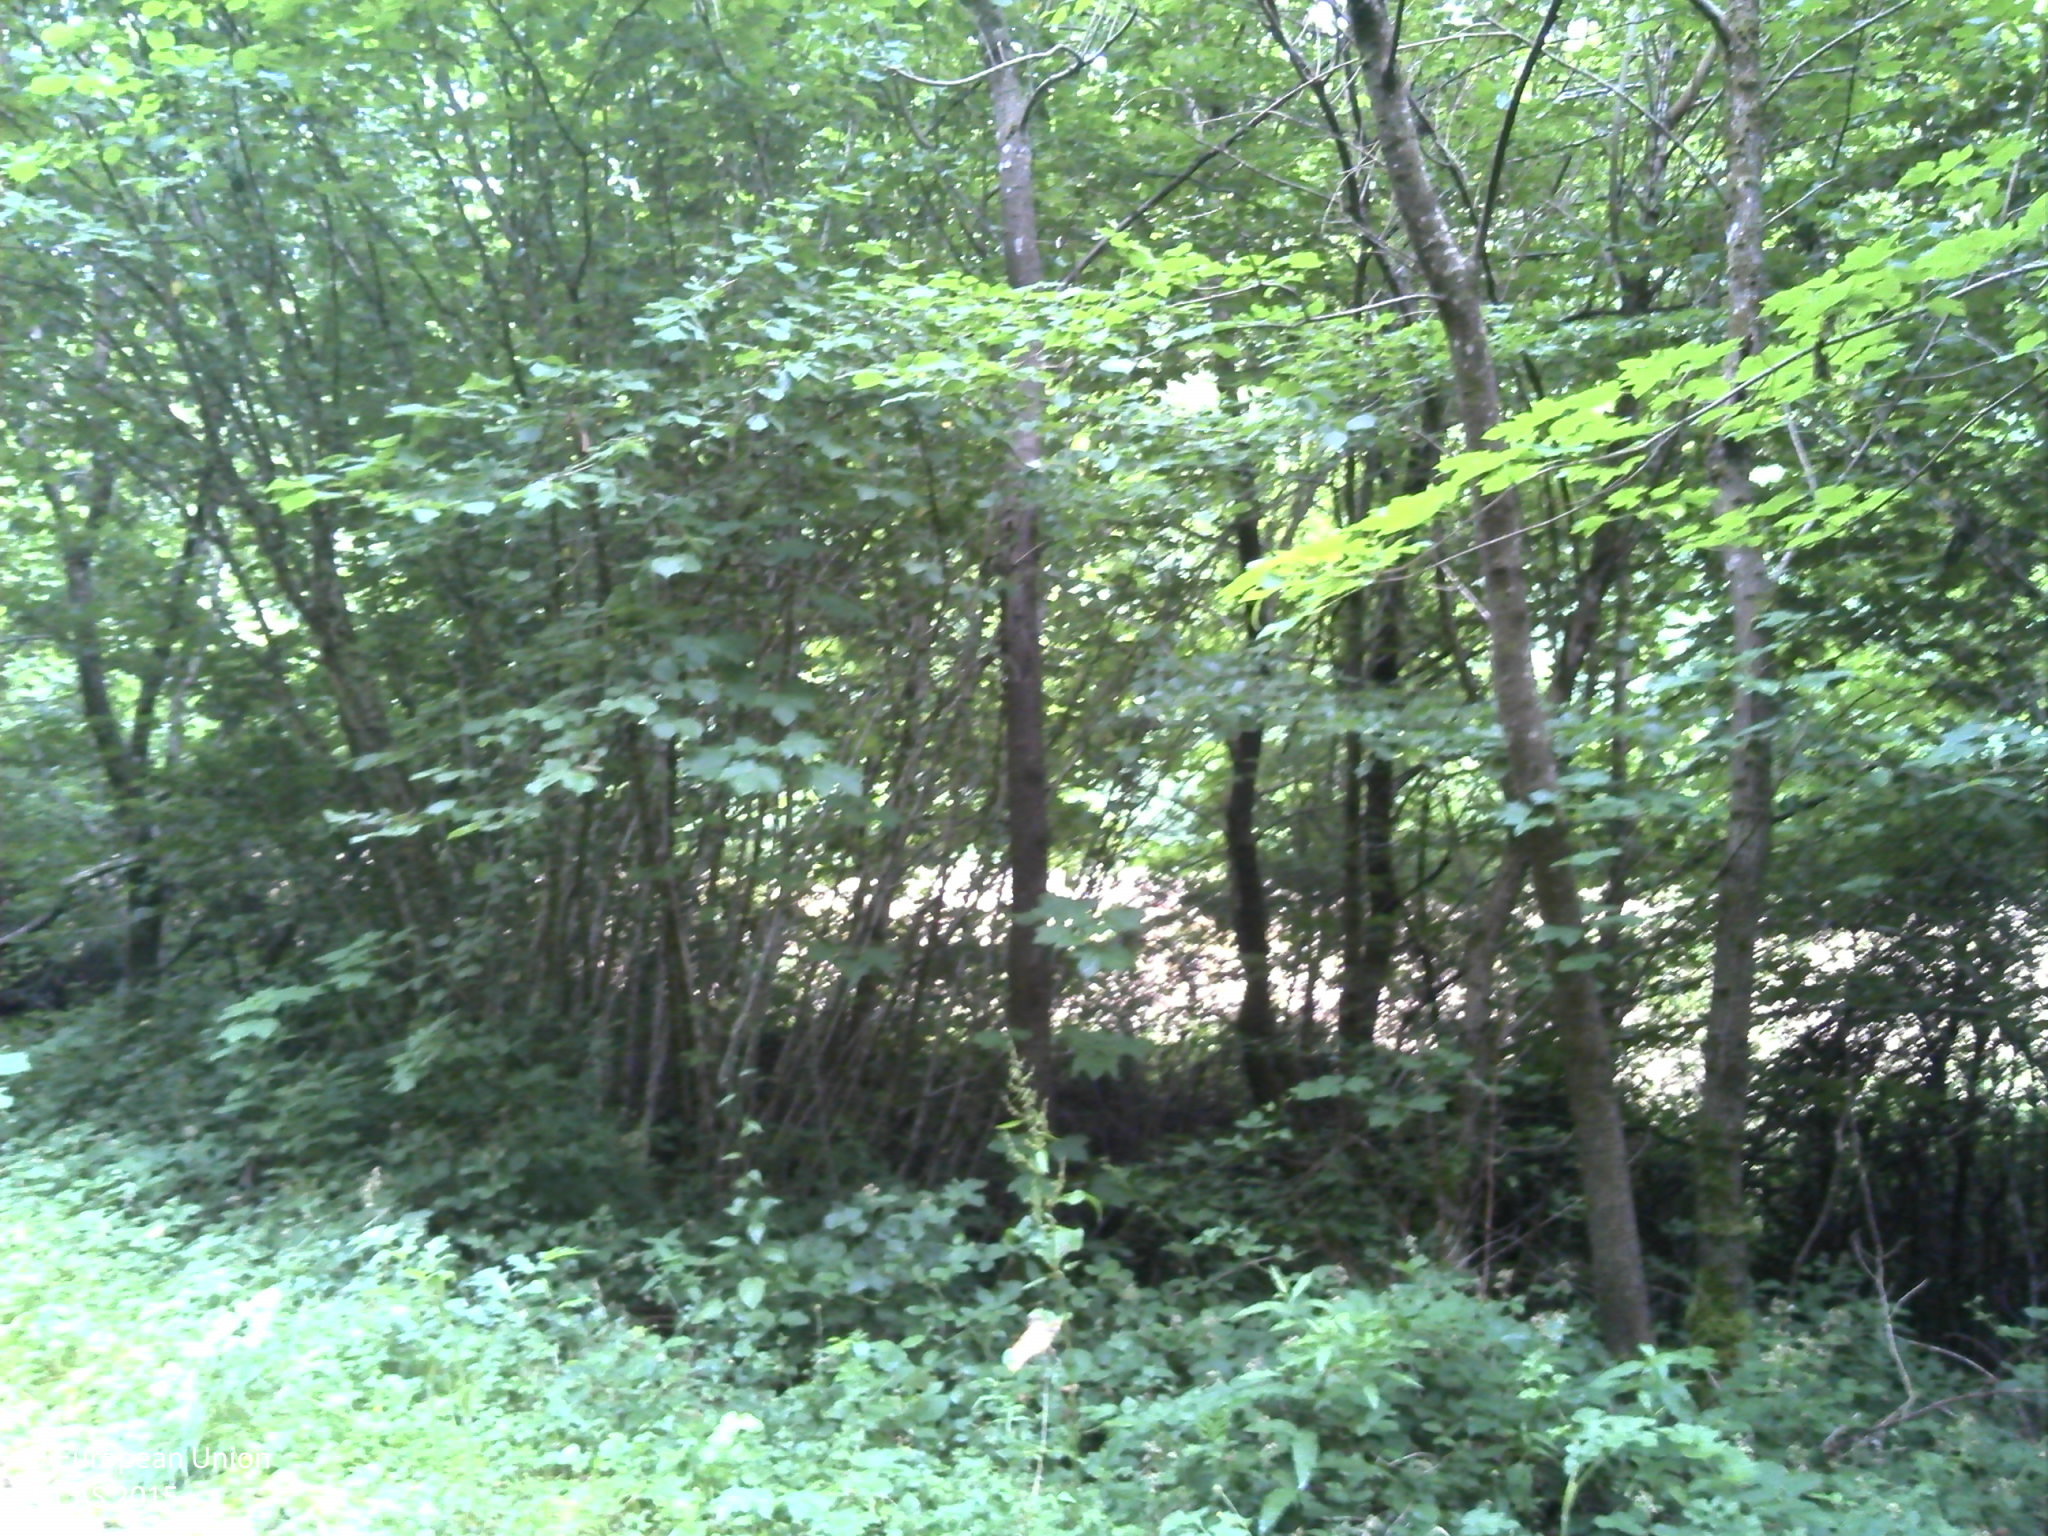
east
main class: Woodland
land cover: Broadleaved woodland
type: mesophytic deciduous forest
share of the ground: > 75 %
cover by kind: broadleaved forest trees 70 %, herbaceous plants 25 %, consolidated bare surface 5 %
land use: Forestry
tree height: > 5 m
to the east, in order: Grass margins; Ditches and canals; Broadleaved woodland; Rivers and streams; Broadleaved woodland; Ditches and canals; Broadleaved woodland
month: July
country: FR
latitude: 49.8319
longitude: 4.8113
